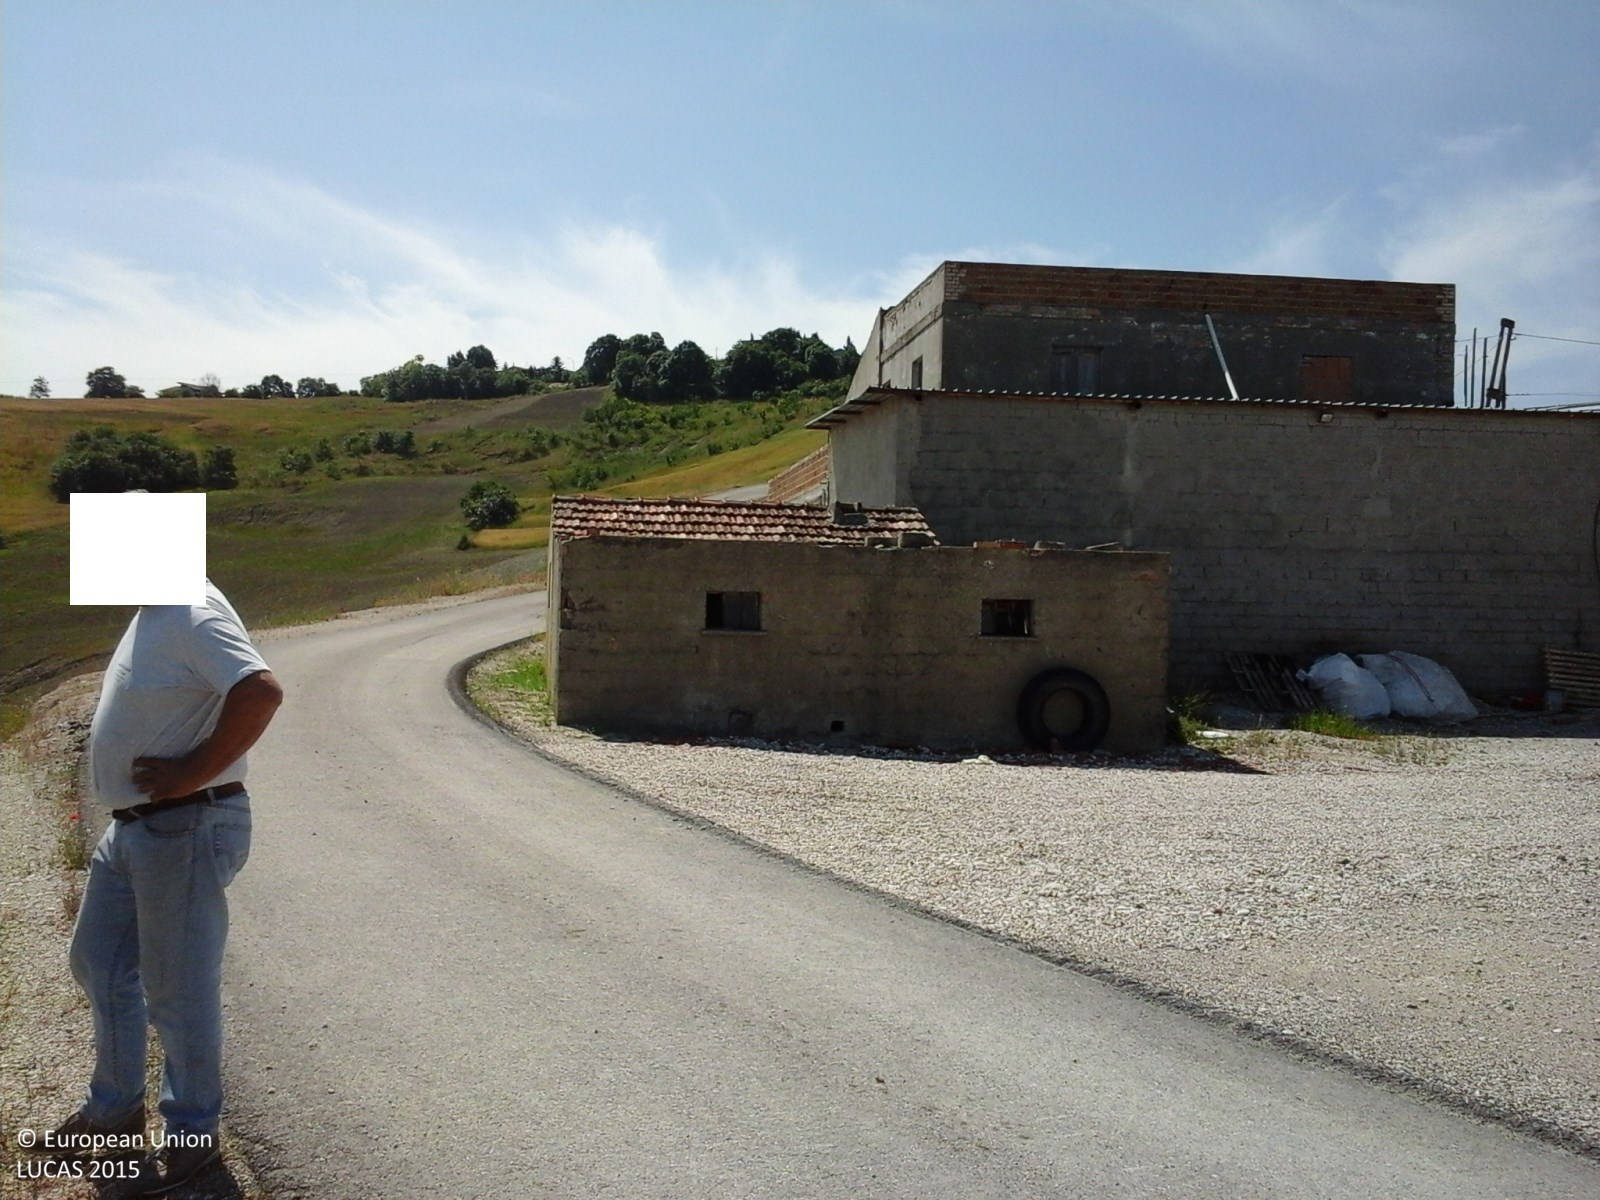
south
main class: Cropland
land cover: Other non-permanent industrial crops
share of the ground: 25 - 50 %
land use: Agriculture (excluding fallow land and kitchen gardens)
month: May
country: IT
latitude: 42.1020
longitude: 14.4963
